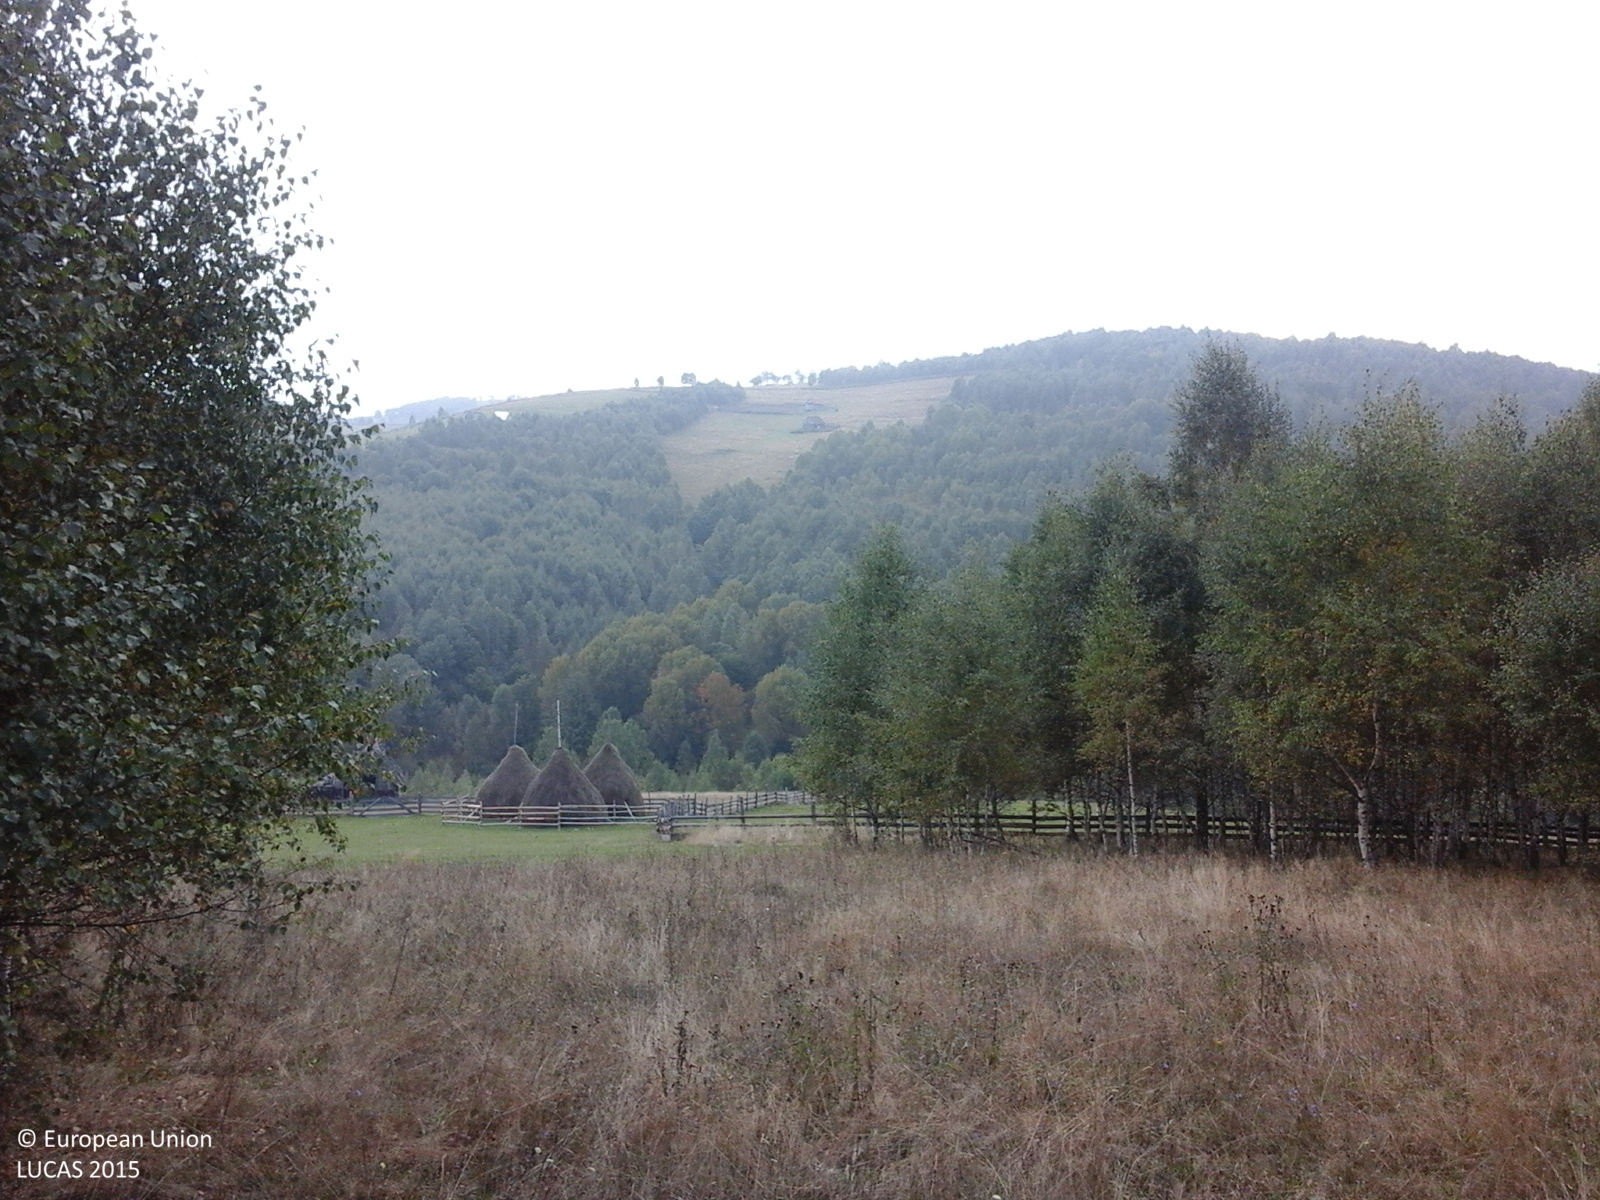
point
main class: Grassland
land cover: Grassland without tree/shrub cover
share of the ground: > 75 %
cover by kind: herbaceous plants 100 %
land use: Agriculture (excluding fallow land and kitchen gardens)
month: October
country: RO
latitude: 45.7560
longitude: 23.7067
